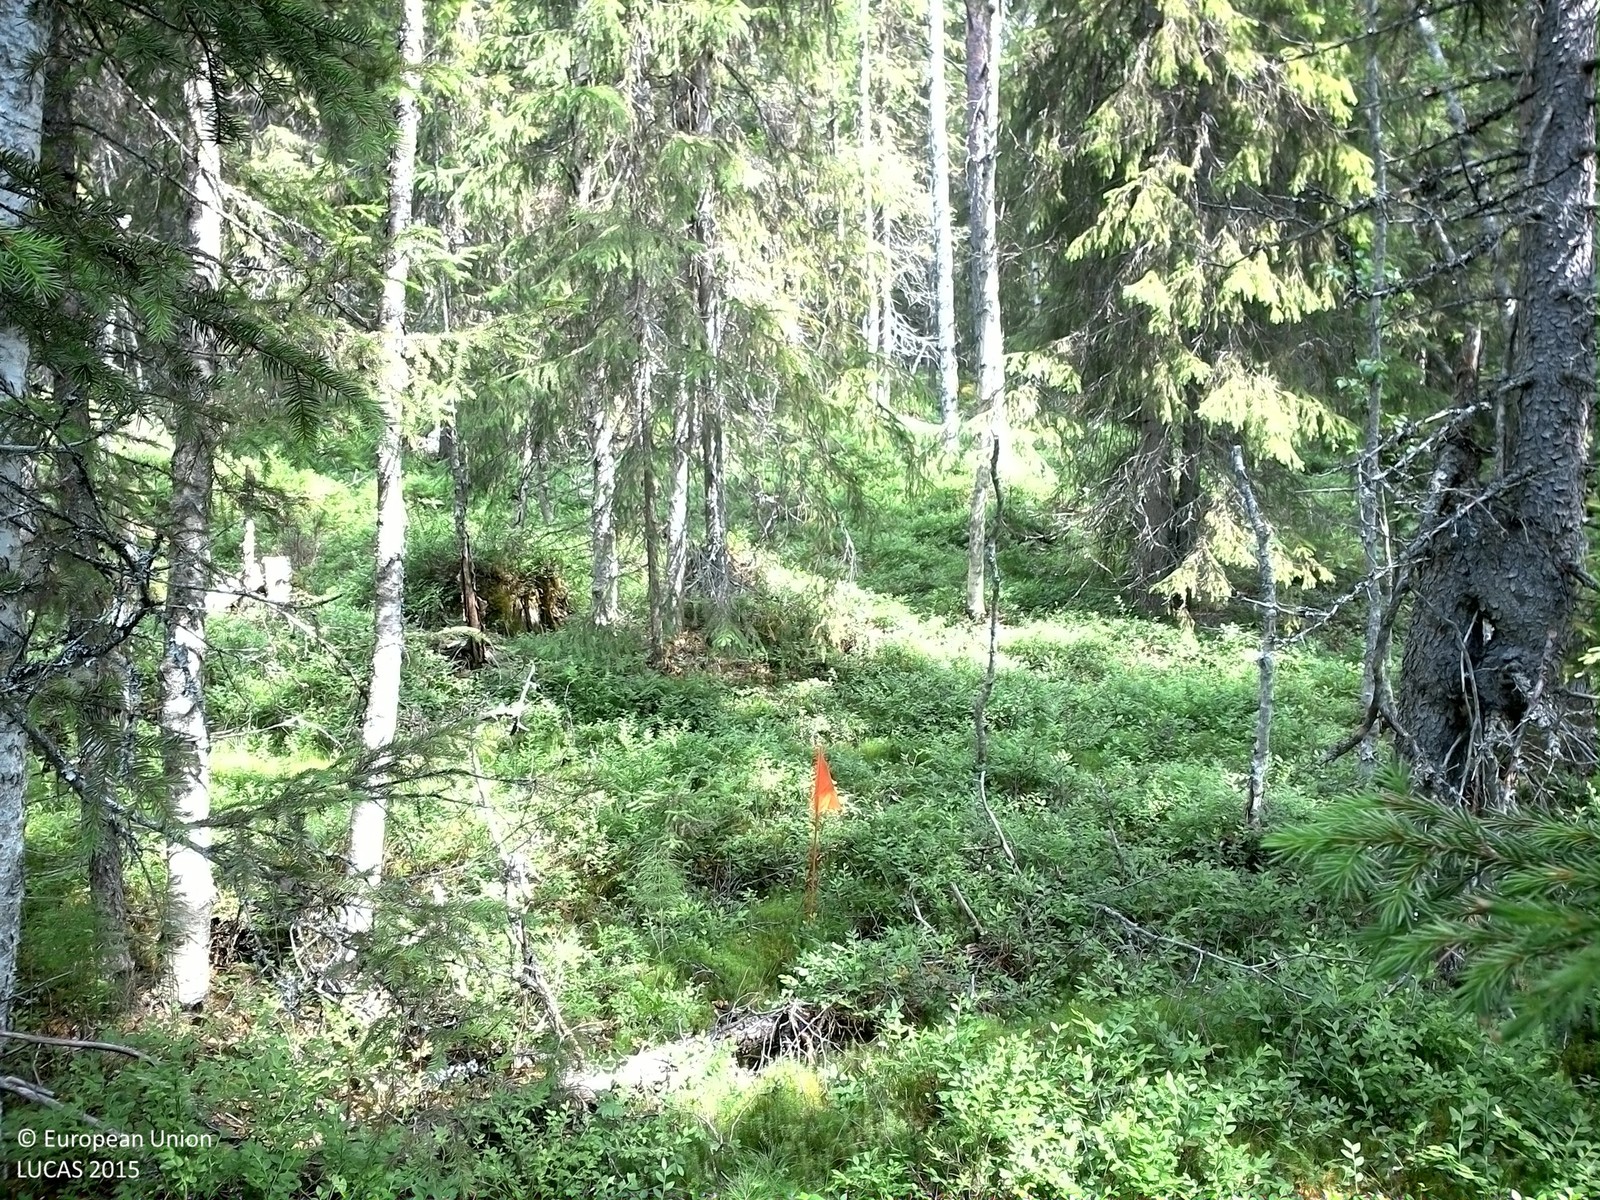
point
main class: Woodland
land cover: Spruce dominated mixed woodland
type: boreal forest
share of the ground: 50 - 75 %
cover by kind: coniferous forest trees 40 %, shrubs 25 %, broadleaved forest trees 15 %, lichens and mosses 15 %, herbaceous plants 5 %
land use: Forestry
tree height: > 5 m
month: July
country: SE
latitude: 63.4787
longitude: 17.4613
